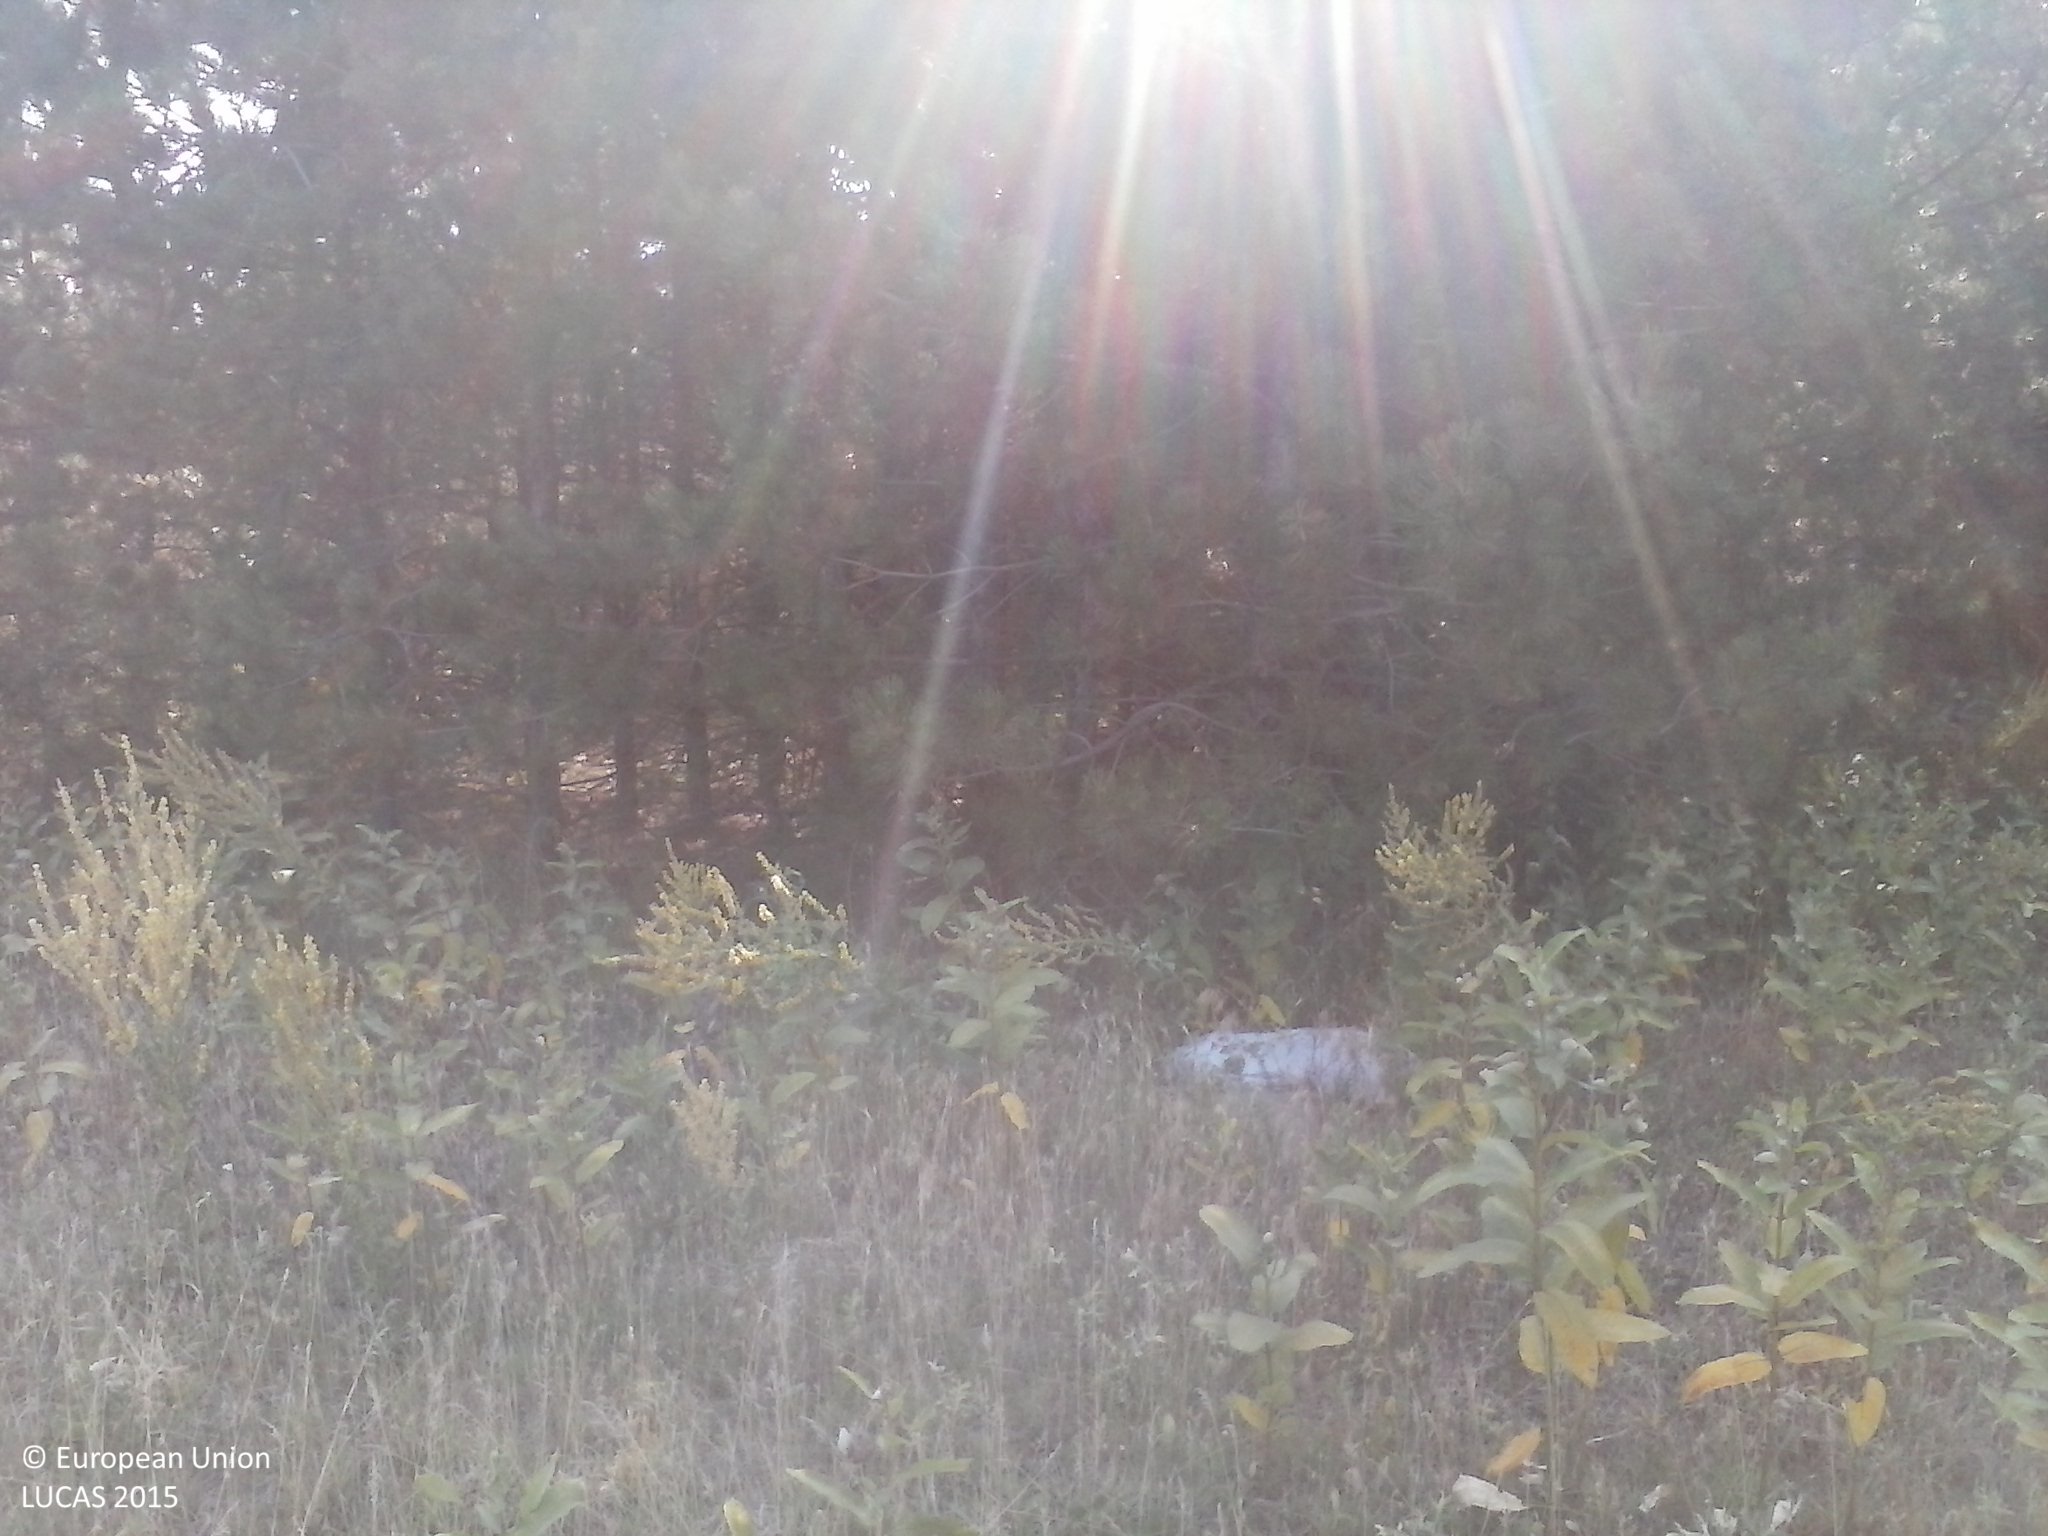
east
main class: Grassland
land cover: Spontaneously vegetated surfaces
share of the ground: > 75 %
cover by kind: herbaceous plants 100 %
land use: Agriculture (excluding fallow land and kitchen gardens)
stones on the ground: < 10 %
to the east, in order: Spontaneously vegetated surfaces; Pine dominated coniferous woodland
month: July
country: HU
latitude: 46.4363
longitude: 19.6889
